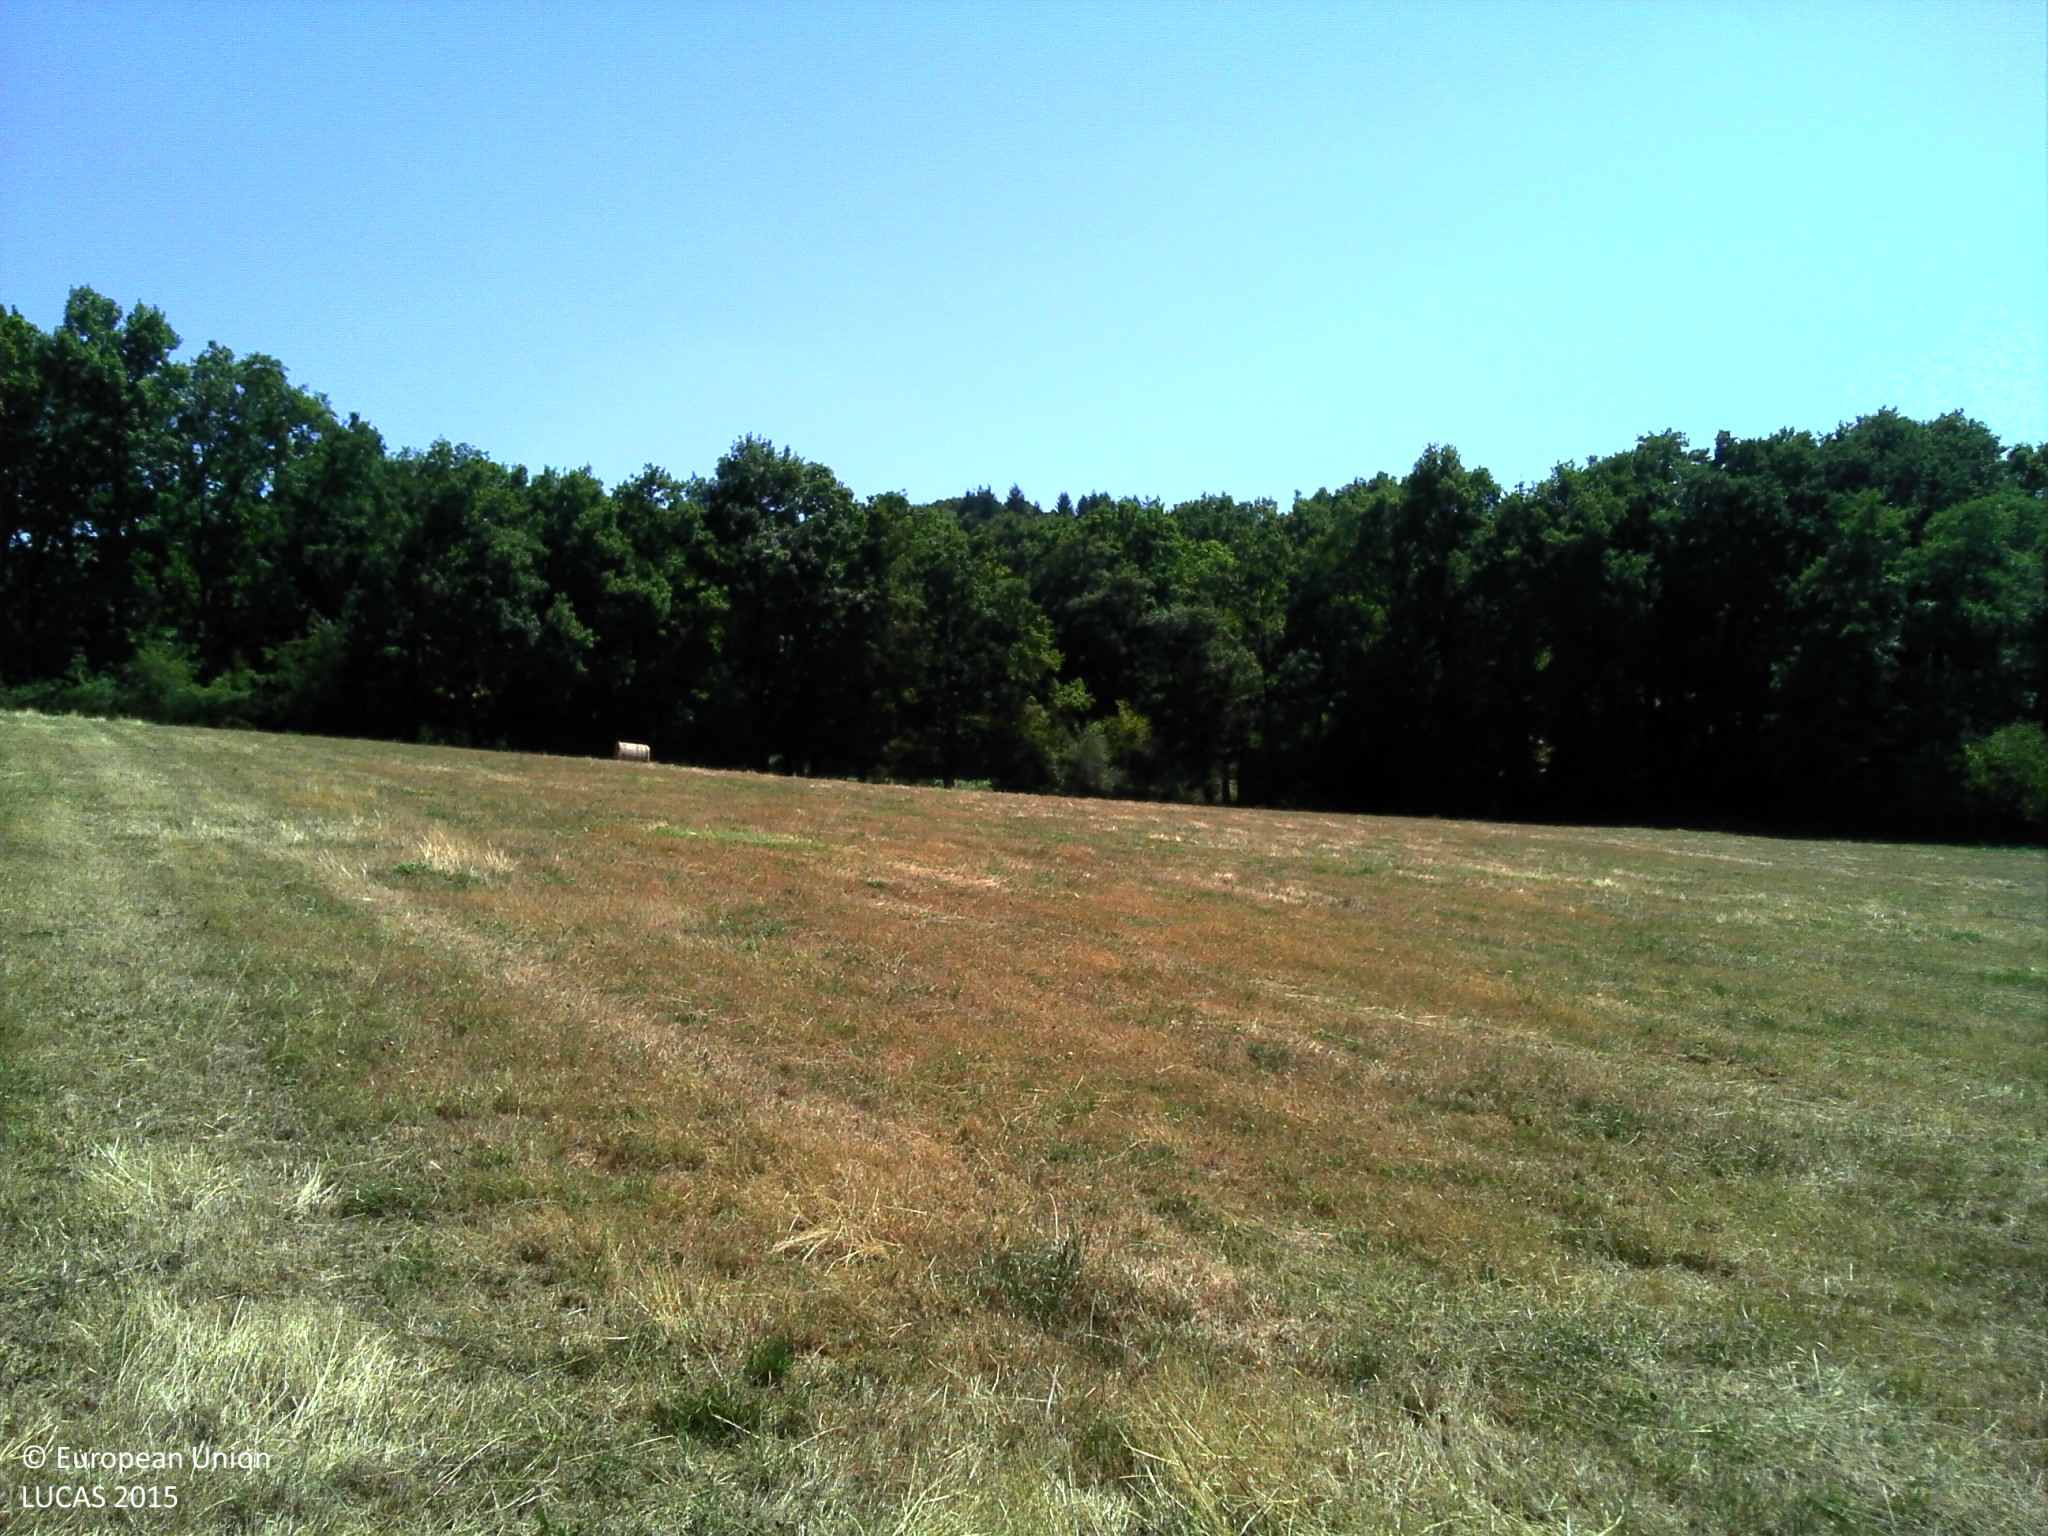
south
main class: Grassland
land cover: Grassland without tree/shrub cover
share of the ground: > 75 %
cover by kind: herbaceous plants 100 %
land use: Agriculture (excluding fallow land and kitchen gardens)
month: August
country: FR
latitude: 46.1441
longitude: 3.6438
